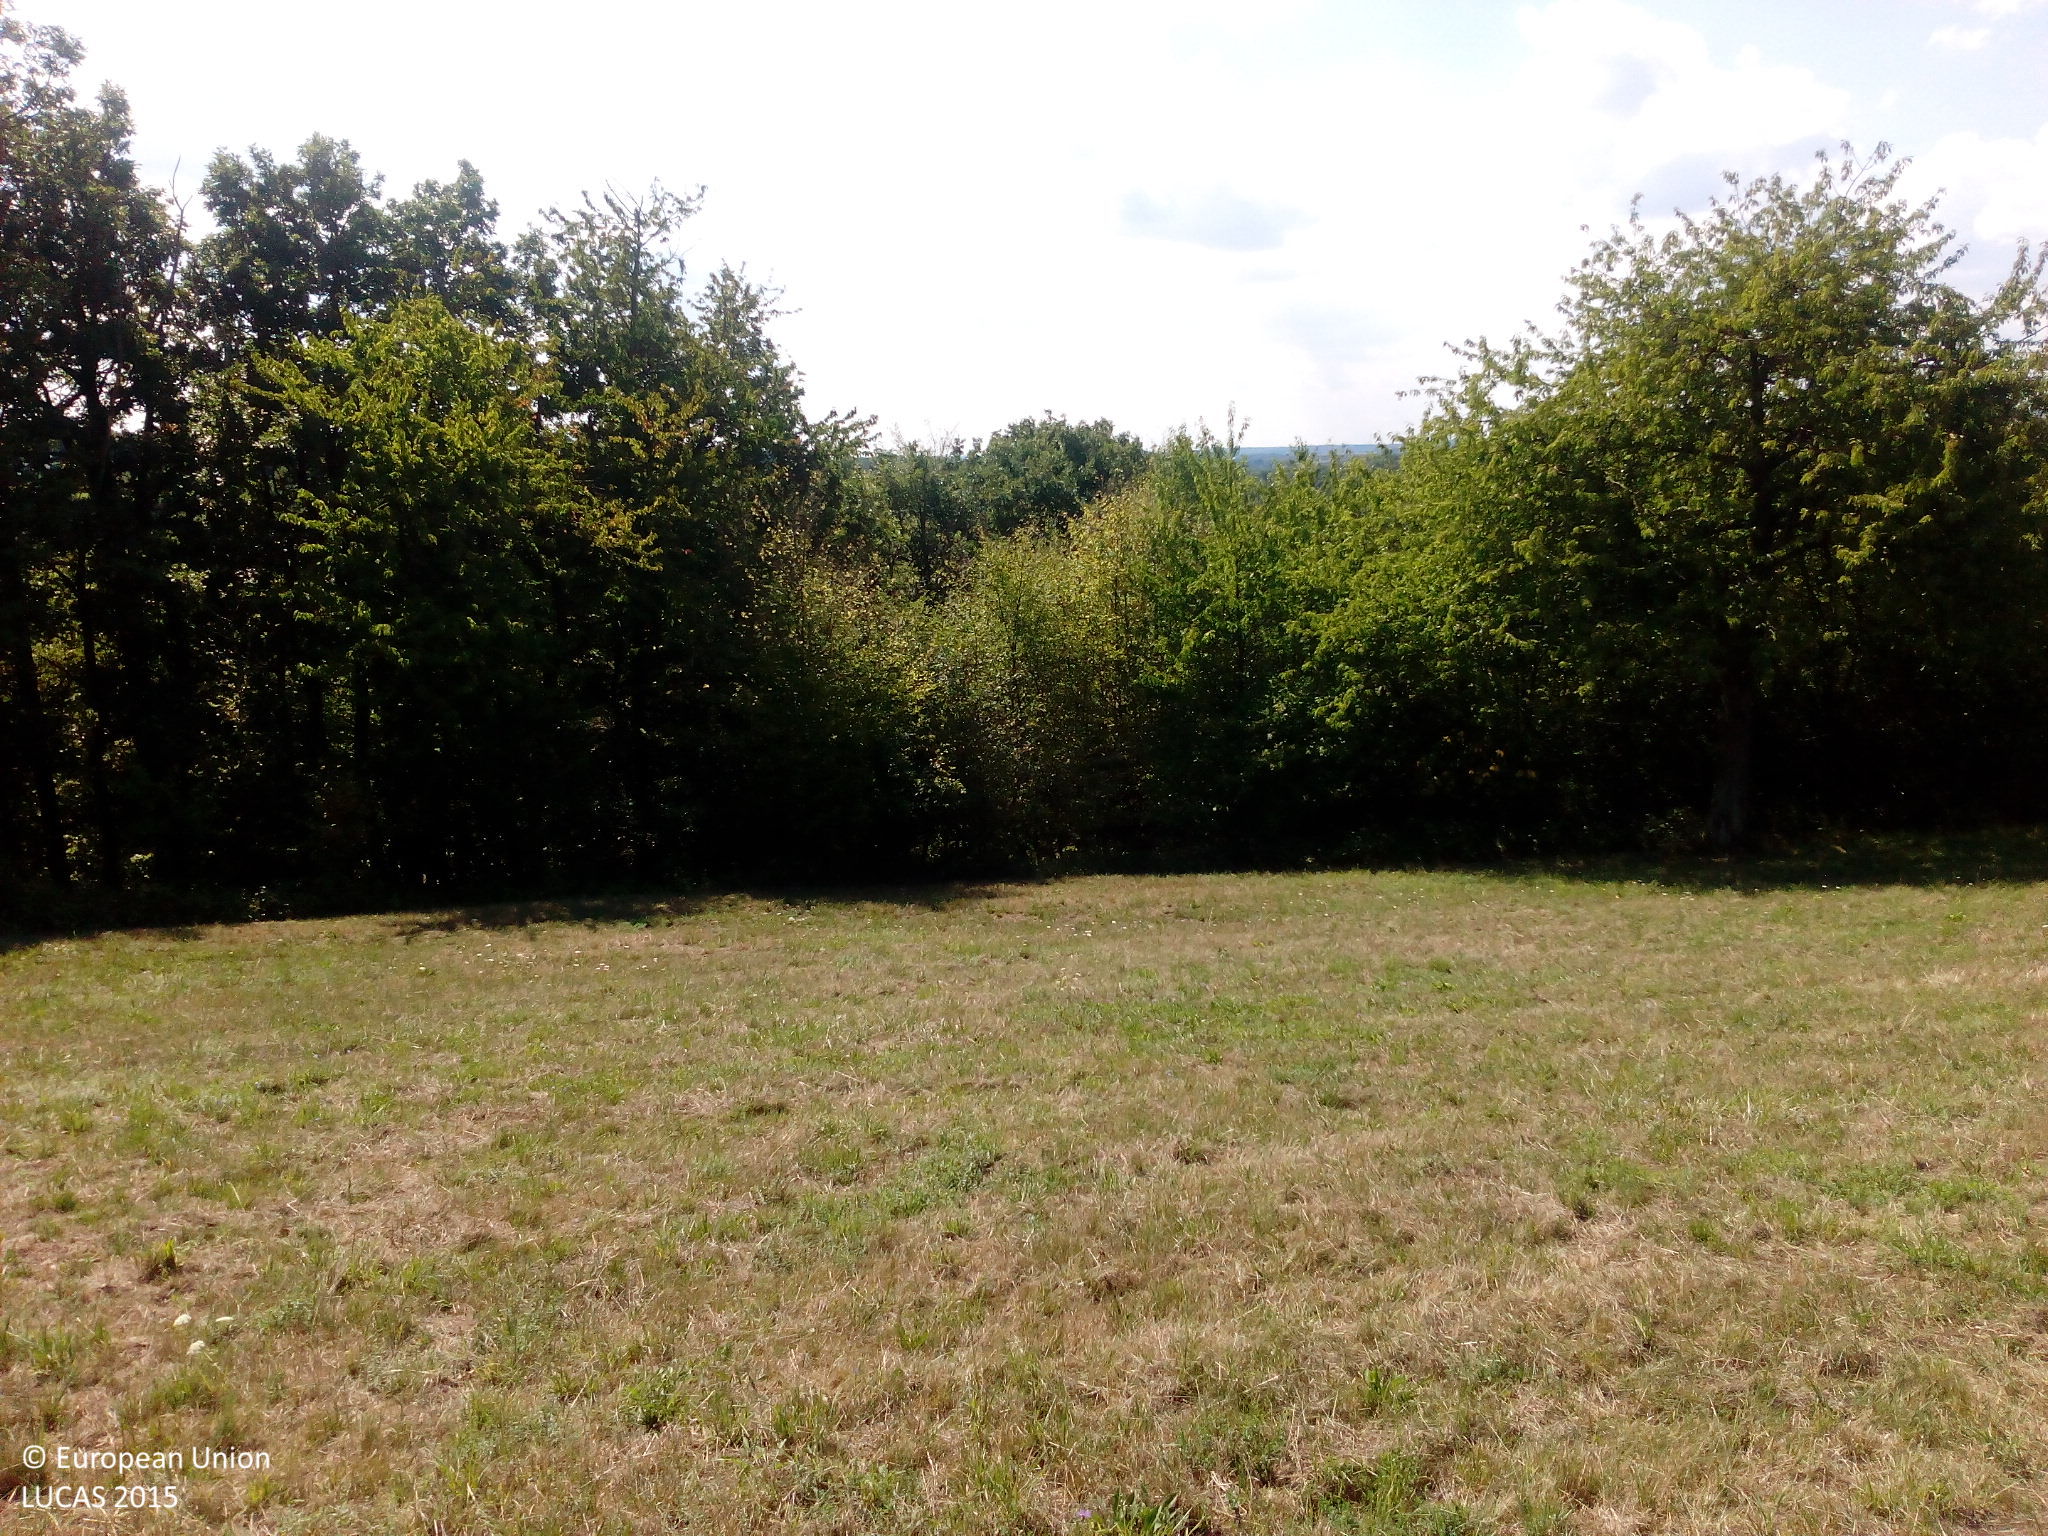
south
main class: Grassland
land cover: Grassland without tree/shrub cover
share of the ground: > 75 %
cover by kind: herbaceous plants 90 %, unconsolidated bare surface 10 %
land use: Agriculture (excluding fallow land and kitchen gardens)
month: August
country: DE
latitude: 50.2280
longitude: 7.4631
